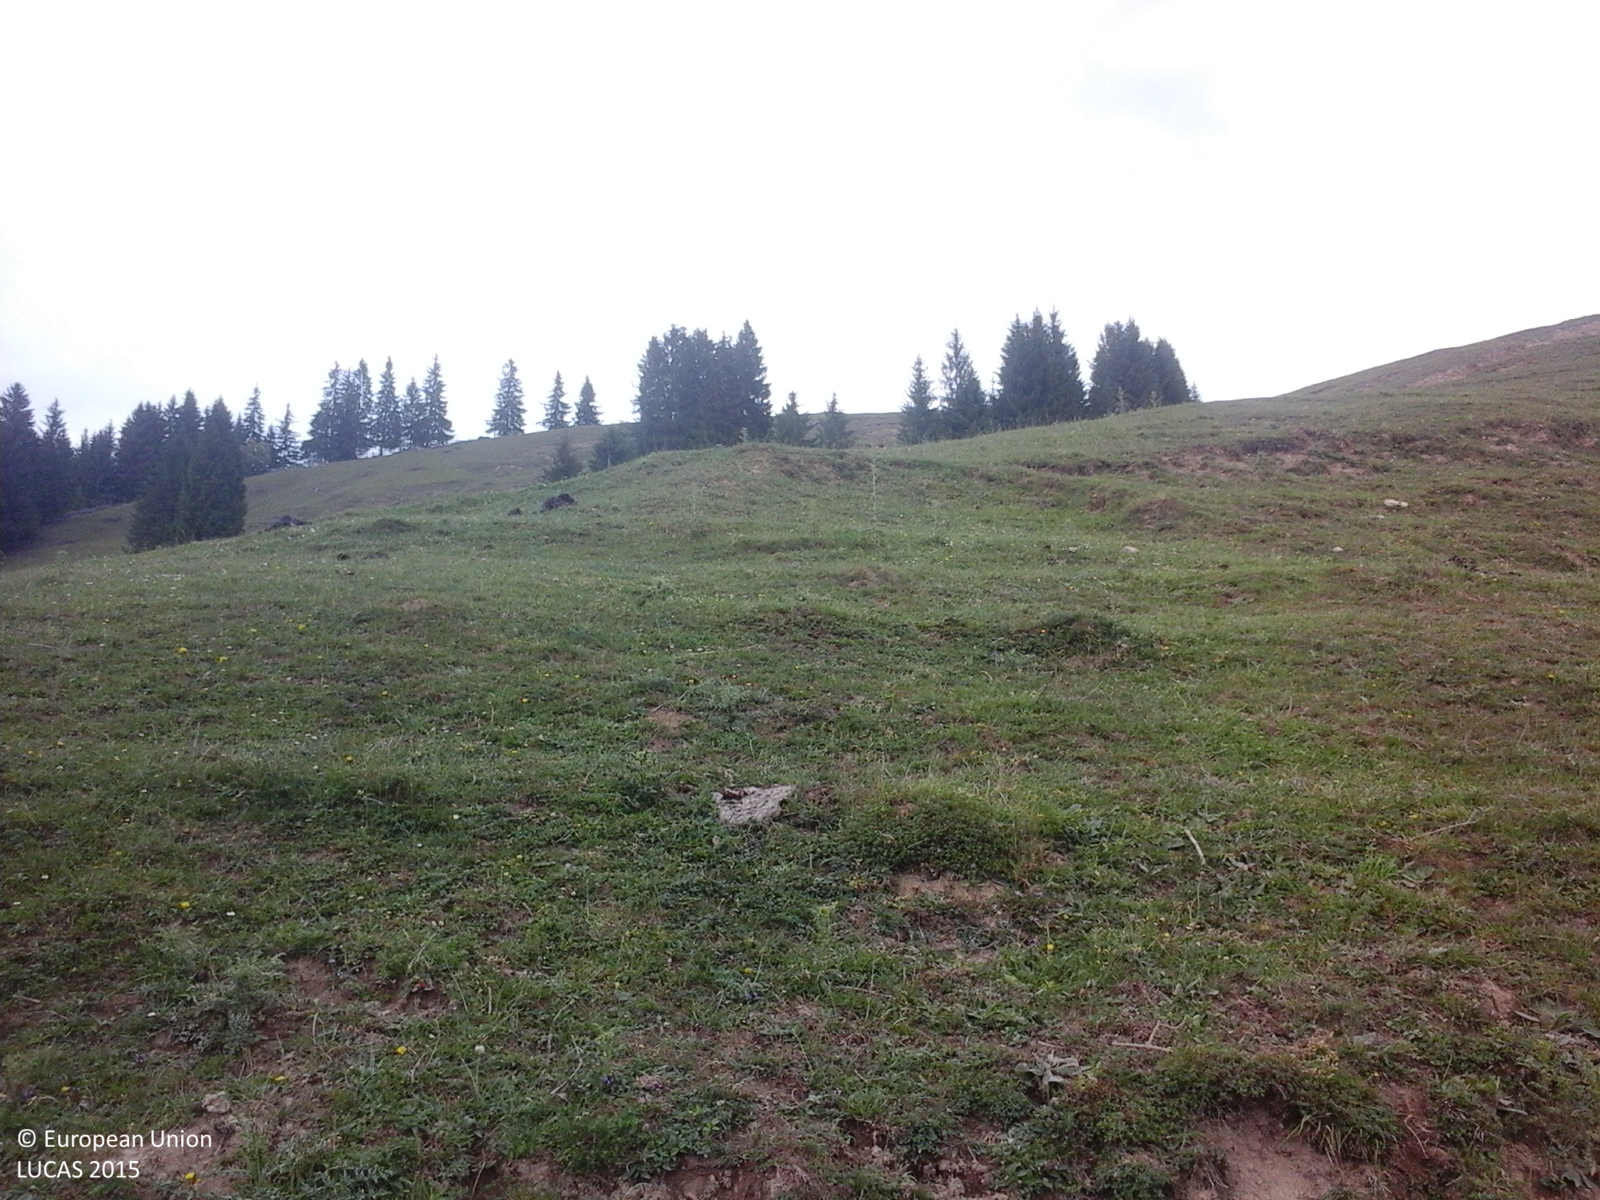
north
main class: Grassland
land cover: Grassland without tree/shrub cover
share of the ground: > 75 %
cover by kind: herbaceous plants 100 %
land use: Agriculture (excluding fallow land and kitchen gardens)
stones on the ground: < 10 %
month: June
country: RO
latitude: 47.7034
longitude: 25.5100
